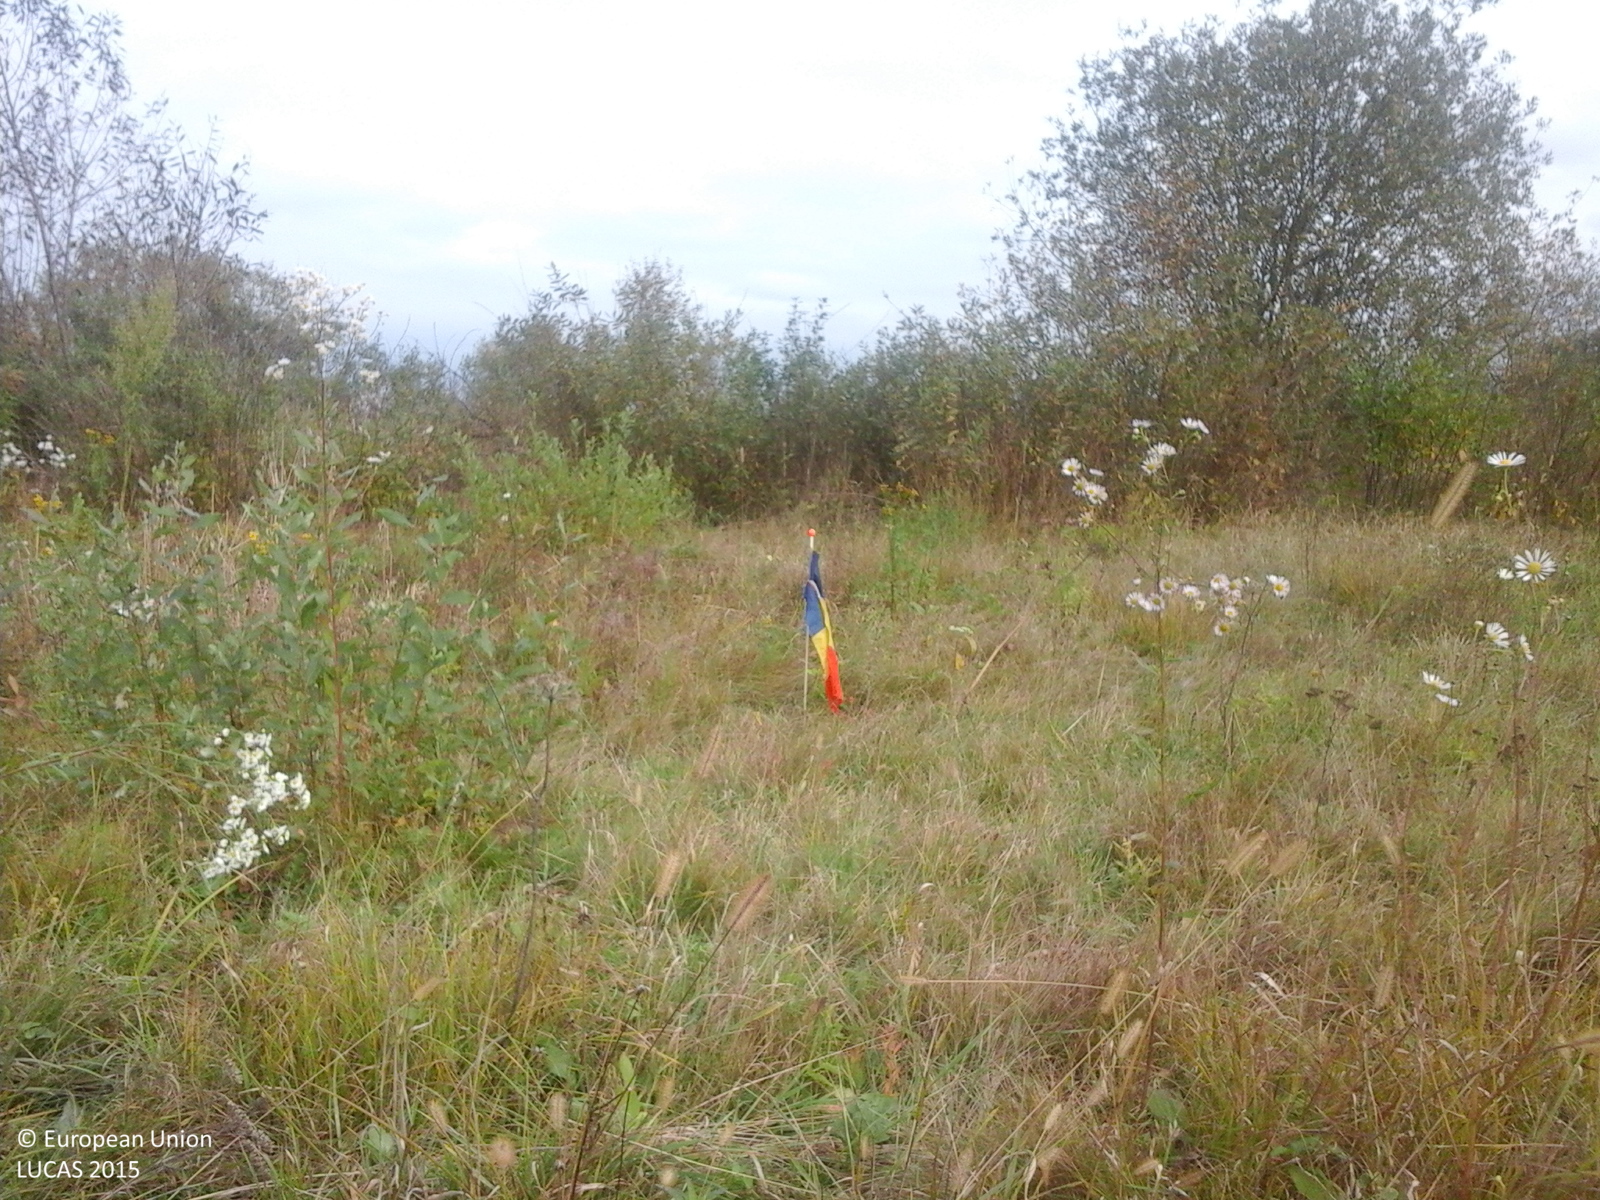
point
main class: Grassland
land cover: Spontaneously vegetated surfaces
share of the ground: > 75 %
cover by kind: herbaceous plants 100 %
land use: Fallow land
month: October
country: RO
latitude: 45.7704
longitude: 24.8119
